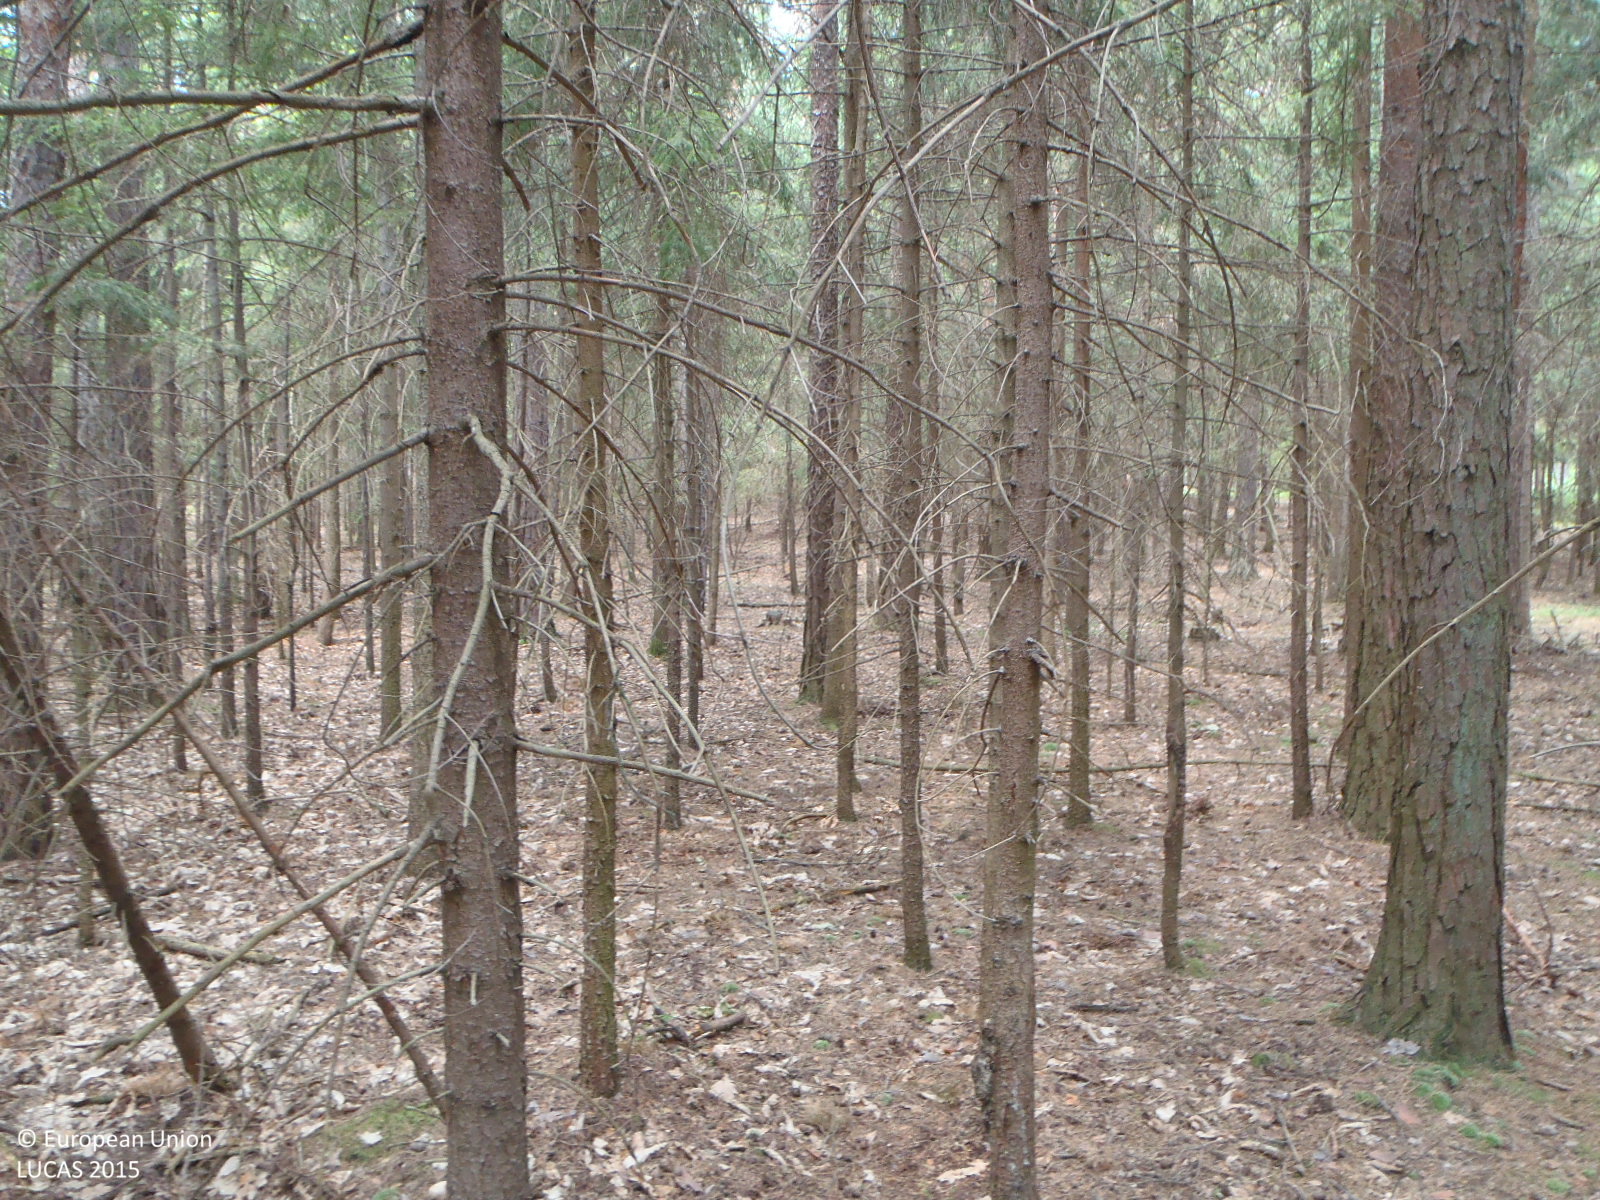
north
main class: Woodland
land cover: Other coniferous woodland
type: hemiboreal forest and nemoral coniferous forest and mixed broadleaved-coniferous forest
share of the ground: > 75 %
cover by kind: coniferous forest trees 95 %, broadleaved forest trees 5 %
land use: Forestry
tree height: > 5 m
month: June
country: CZ
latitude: 48.9472
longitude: 14.3840
